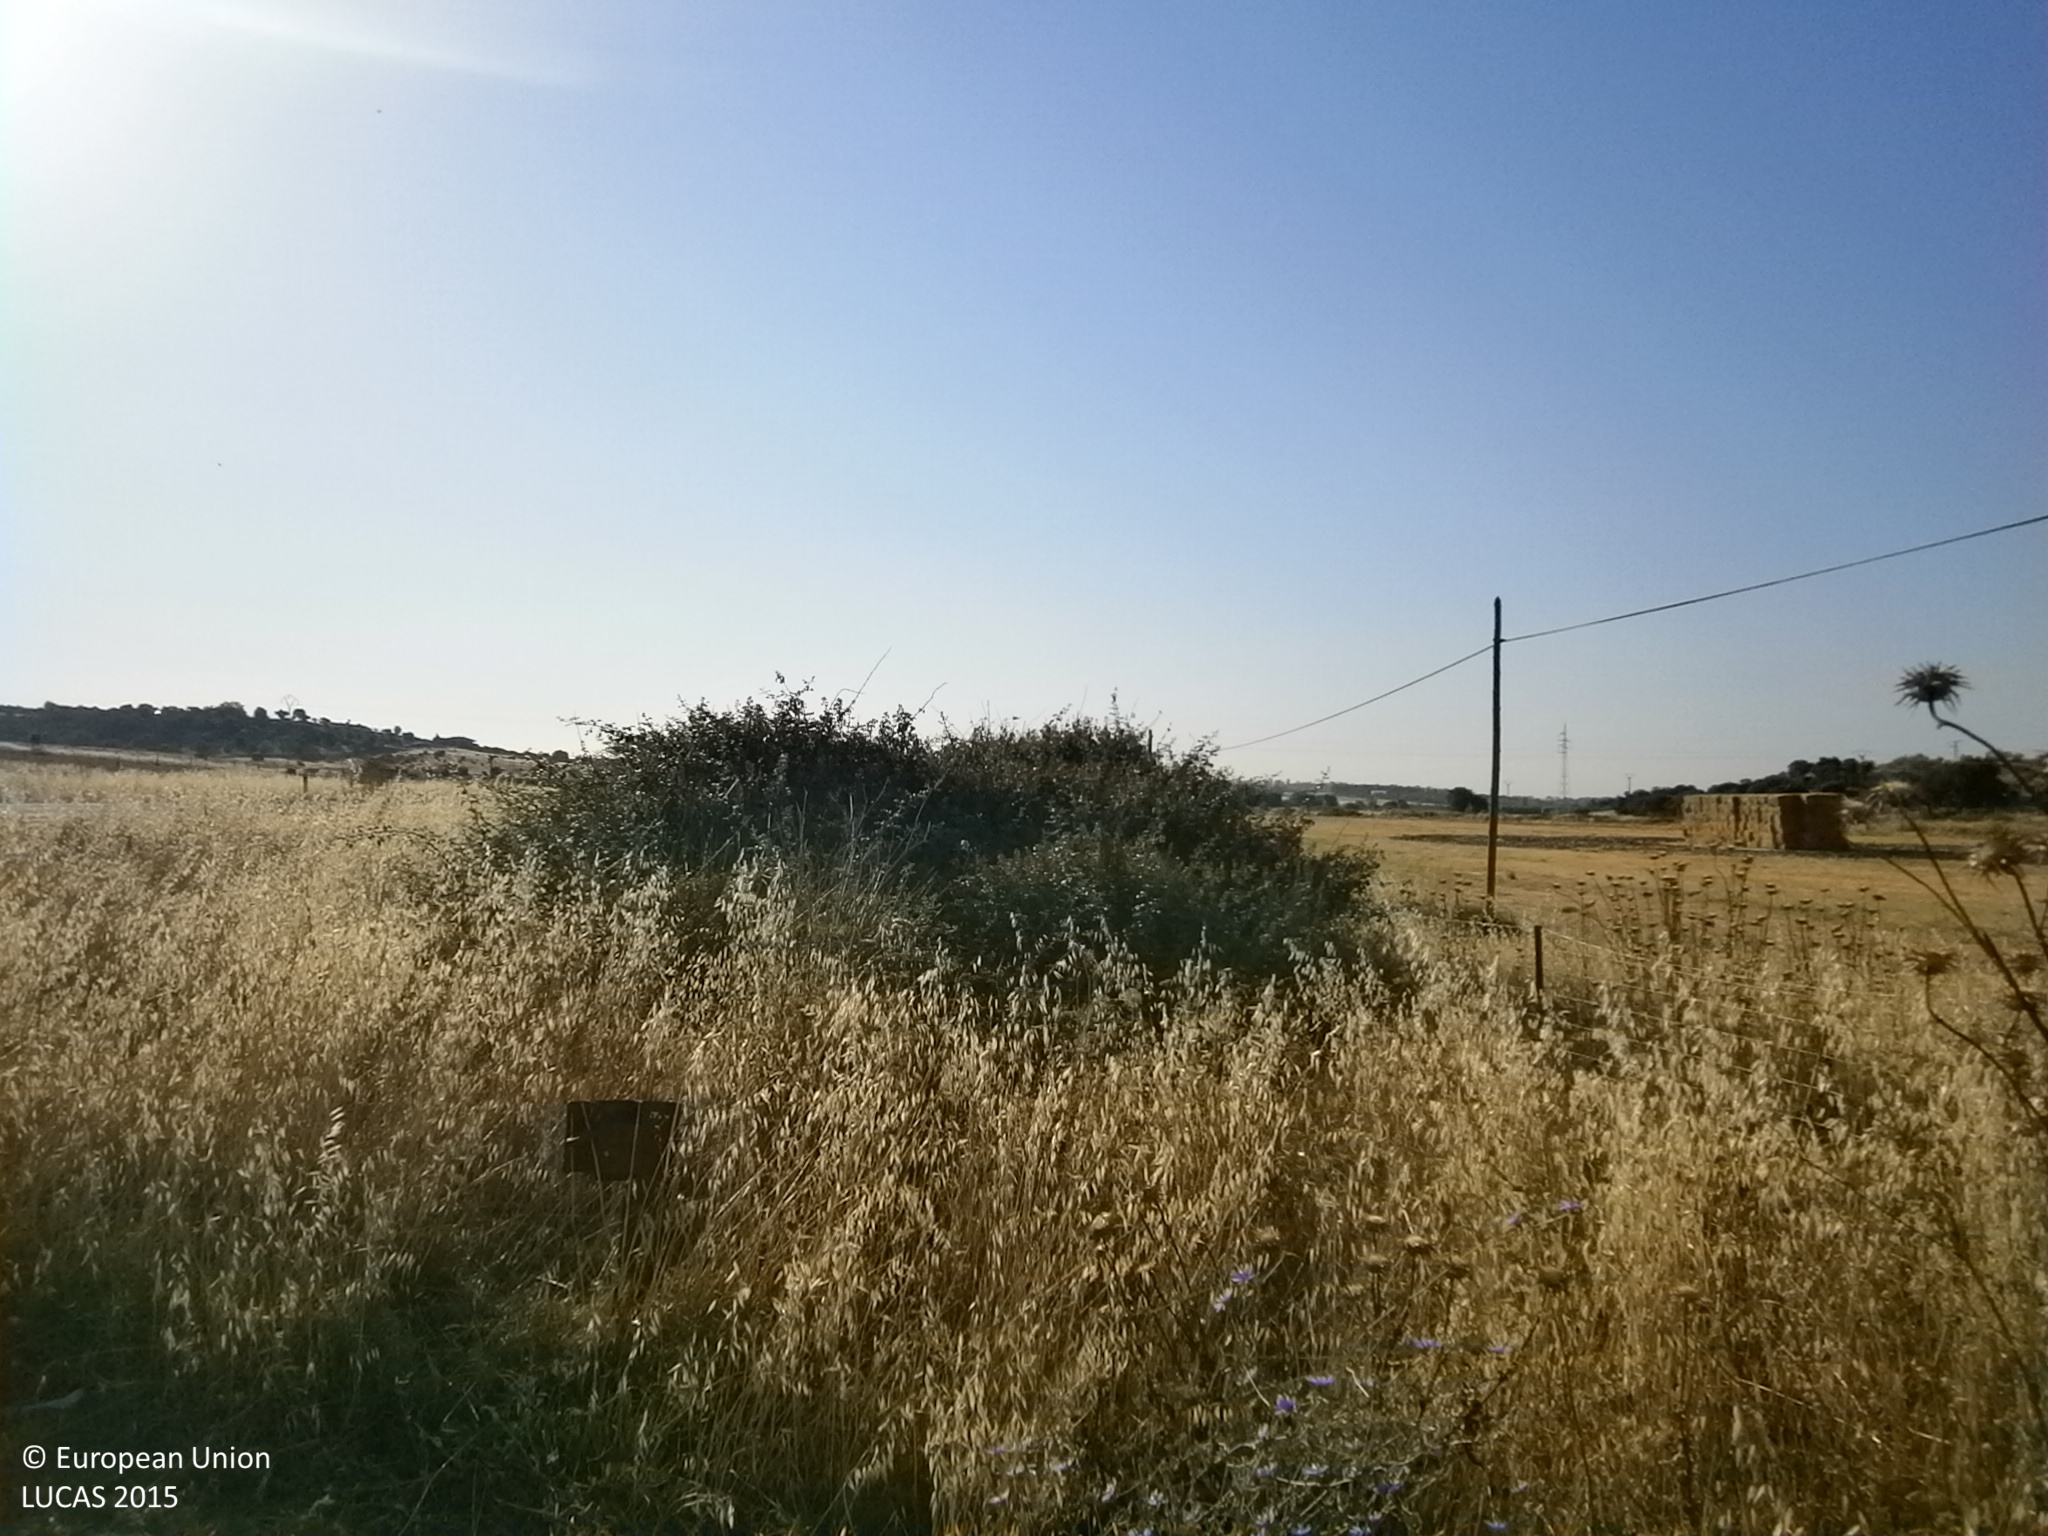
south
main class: Cropland
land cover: Oats
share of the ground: > 75 %
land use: Agriculture (excluding fallow land and kitchen gardens)
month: June
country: ES
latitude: 38.8092
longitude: -6.8915
